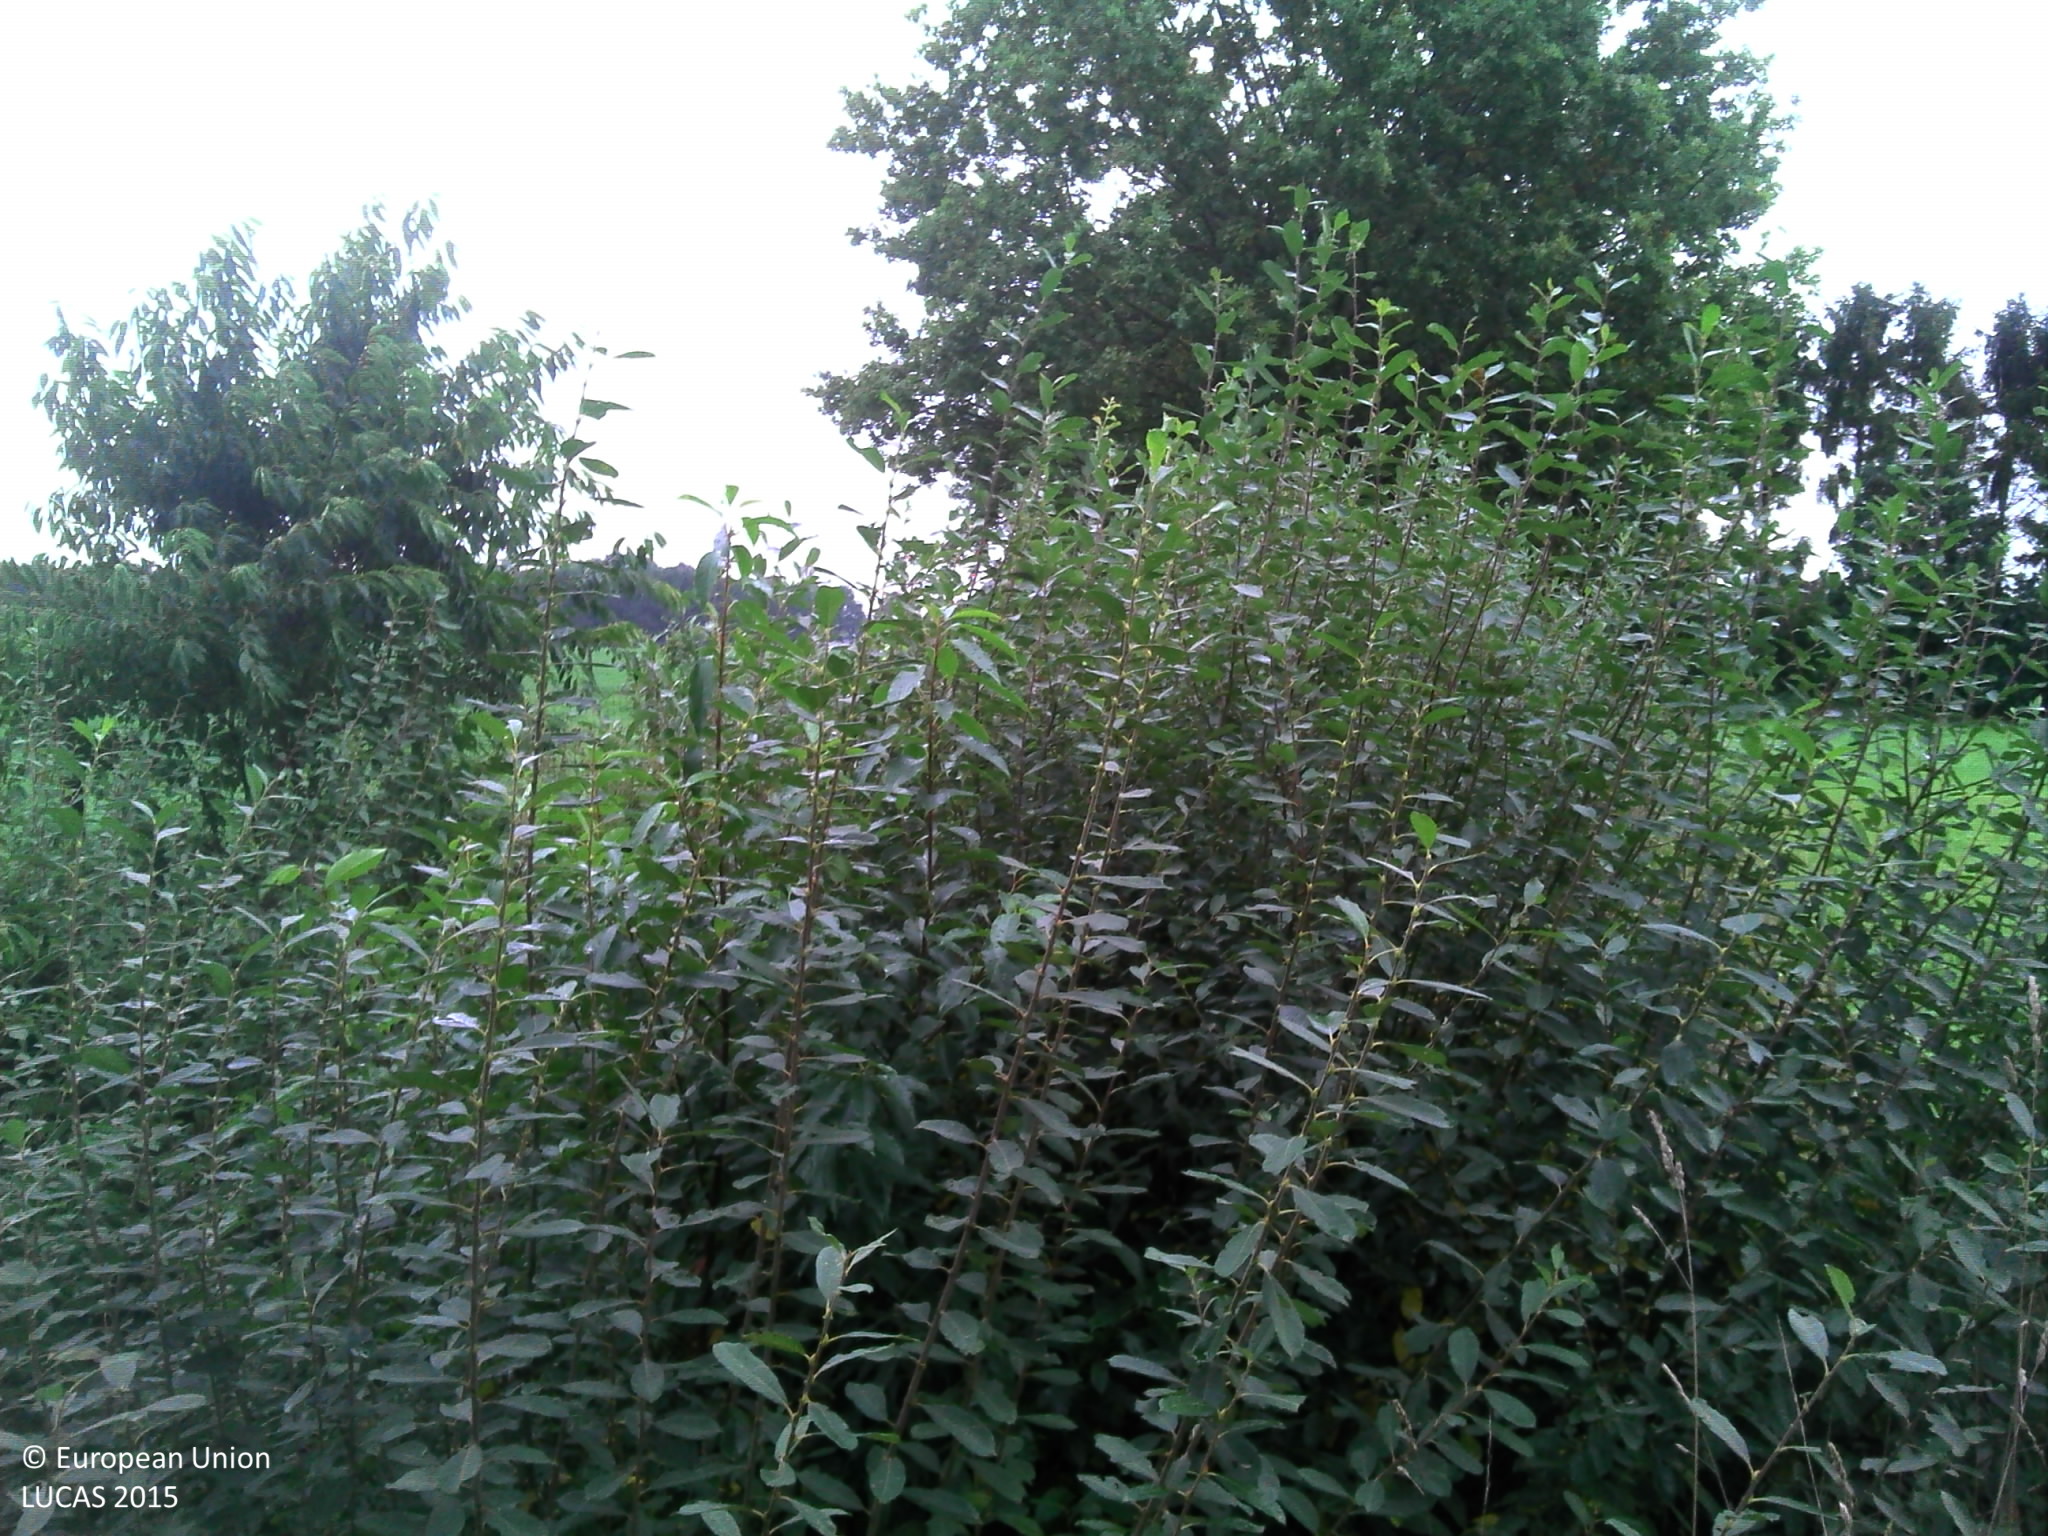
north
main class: Grassland
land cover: Grassland without tree/shrub cover
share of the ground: > 75 %
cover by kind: herbaceous plants 100 %
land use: Agriculture (excluding fallow land and kitchen gardens)
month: October
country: BE
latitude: 51.1291
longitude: 4.8095
